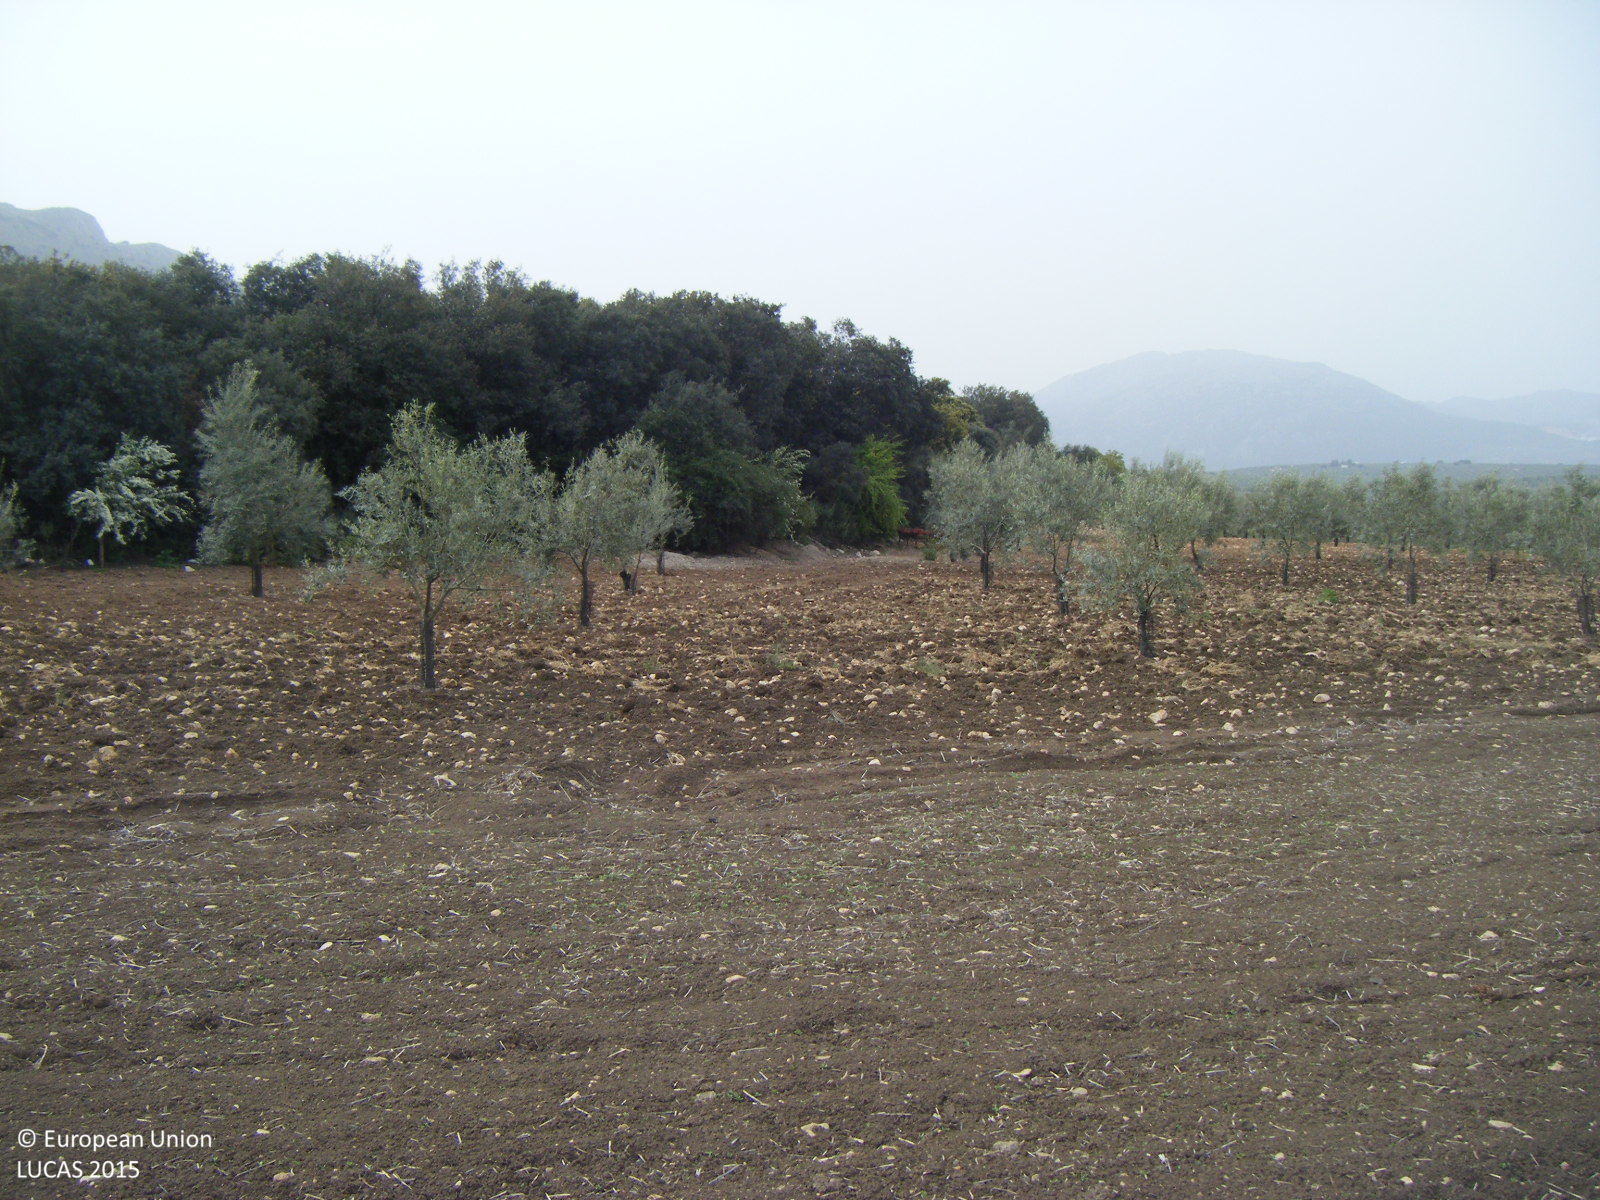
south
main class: Cropland
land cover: Other non-permanent industrial crops
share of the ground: < 10 %
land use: Agriculture (excluding fallow land and kitchen gardens)
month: April
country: ES
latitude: 37.0847
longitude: -4.2929
